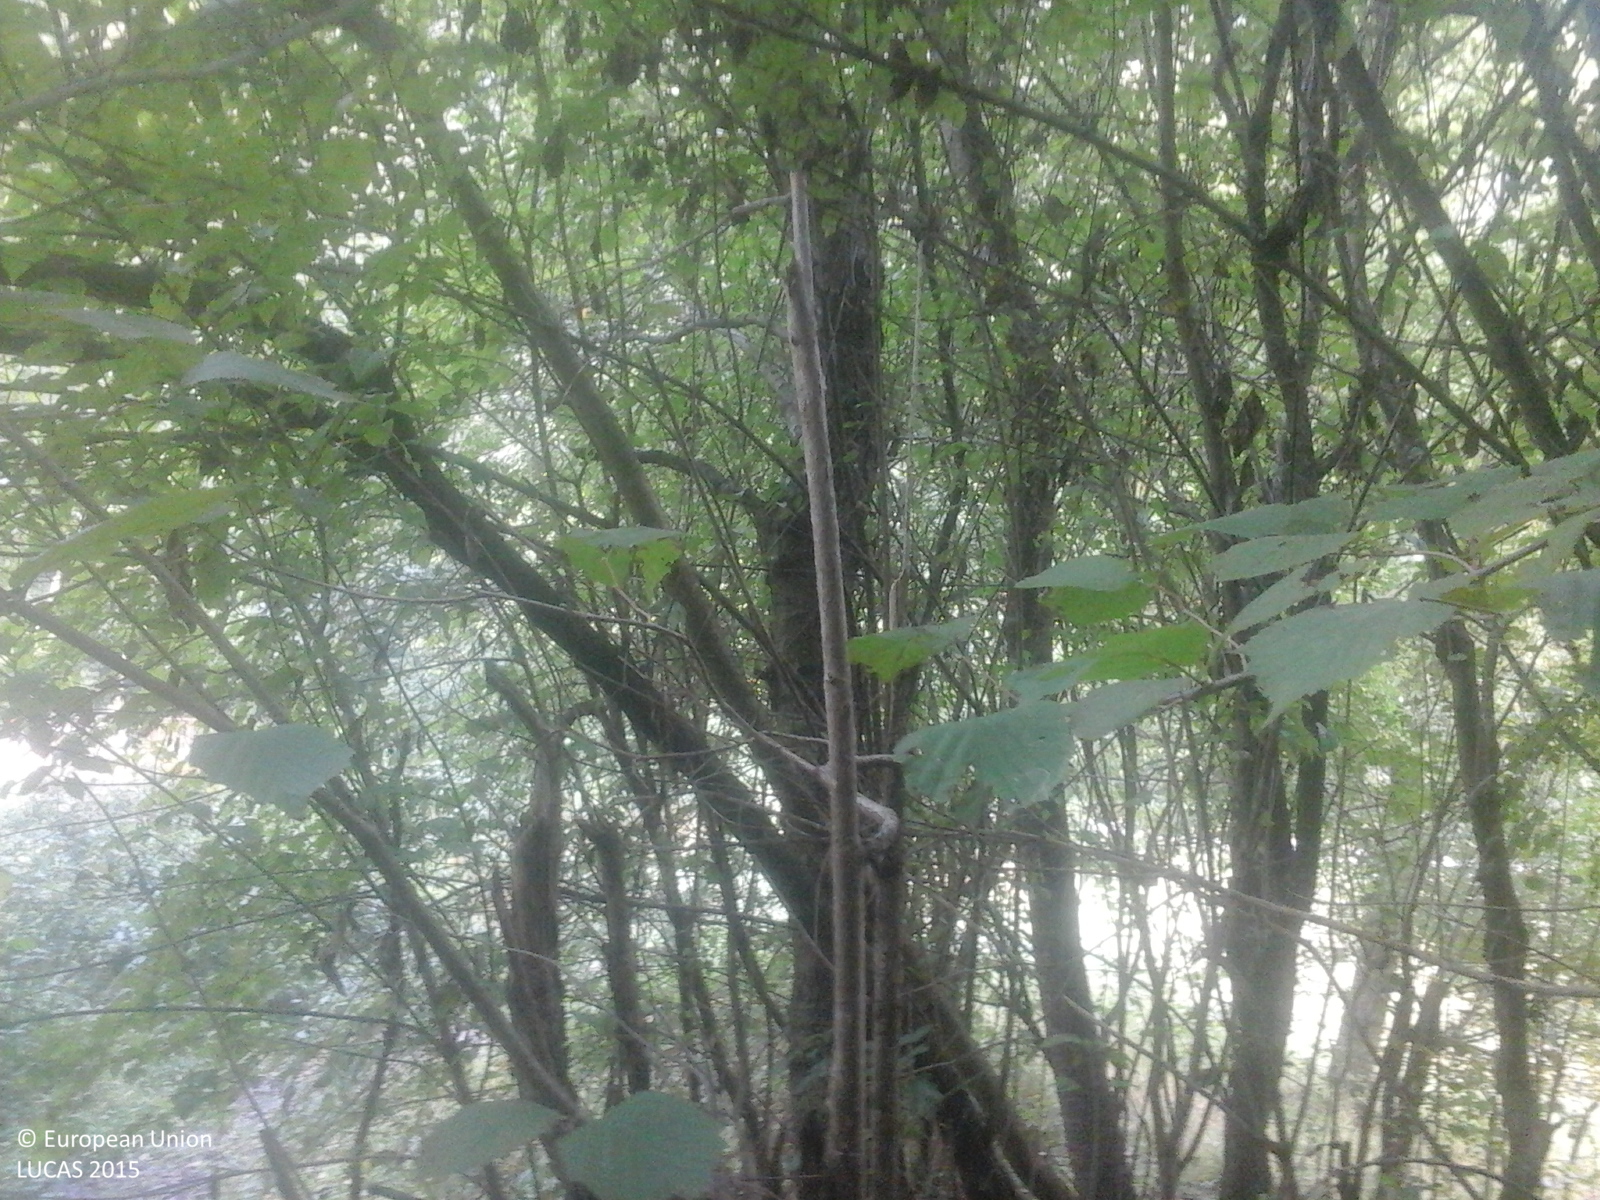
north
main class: Woodland
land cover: Broadleaved woodland
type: mesophytic deciduous forest
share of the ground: > 75 %
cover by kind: broadleaved forest trees 100 %
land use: Forestry
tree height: > 5 m
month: September
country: RO
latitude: 45.6502
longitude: 23.1055
